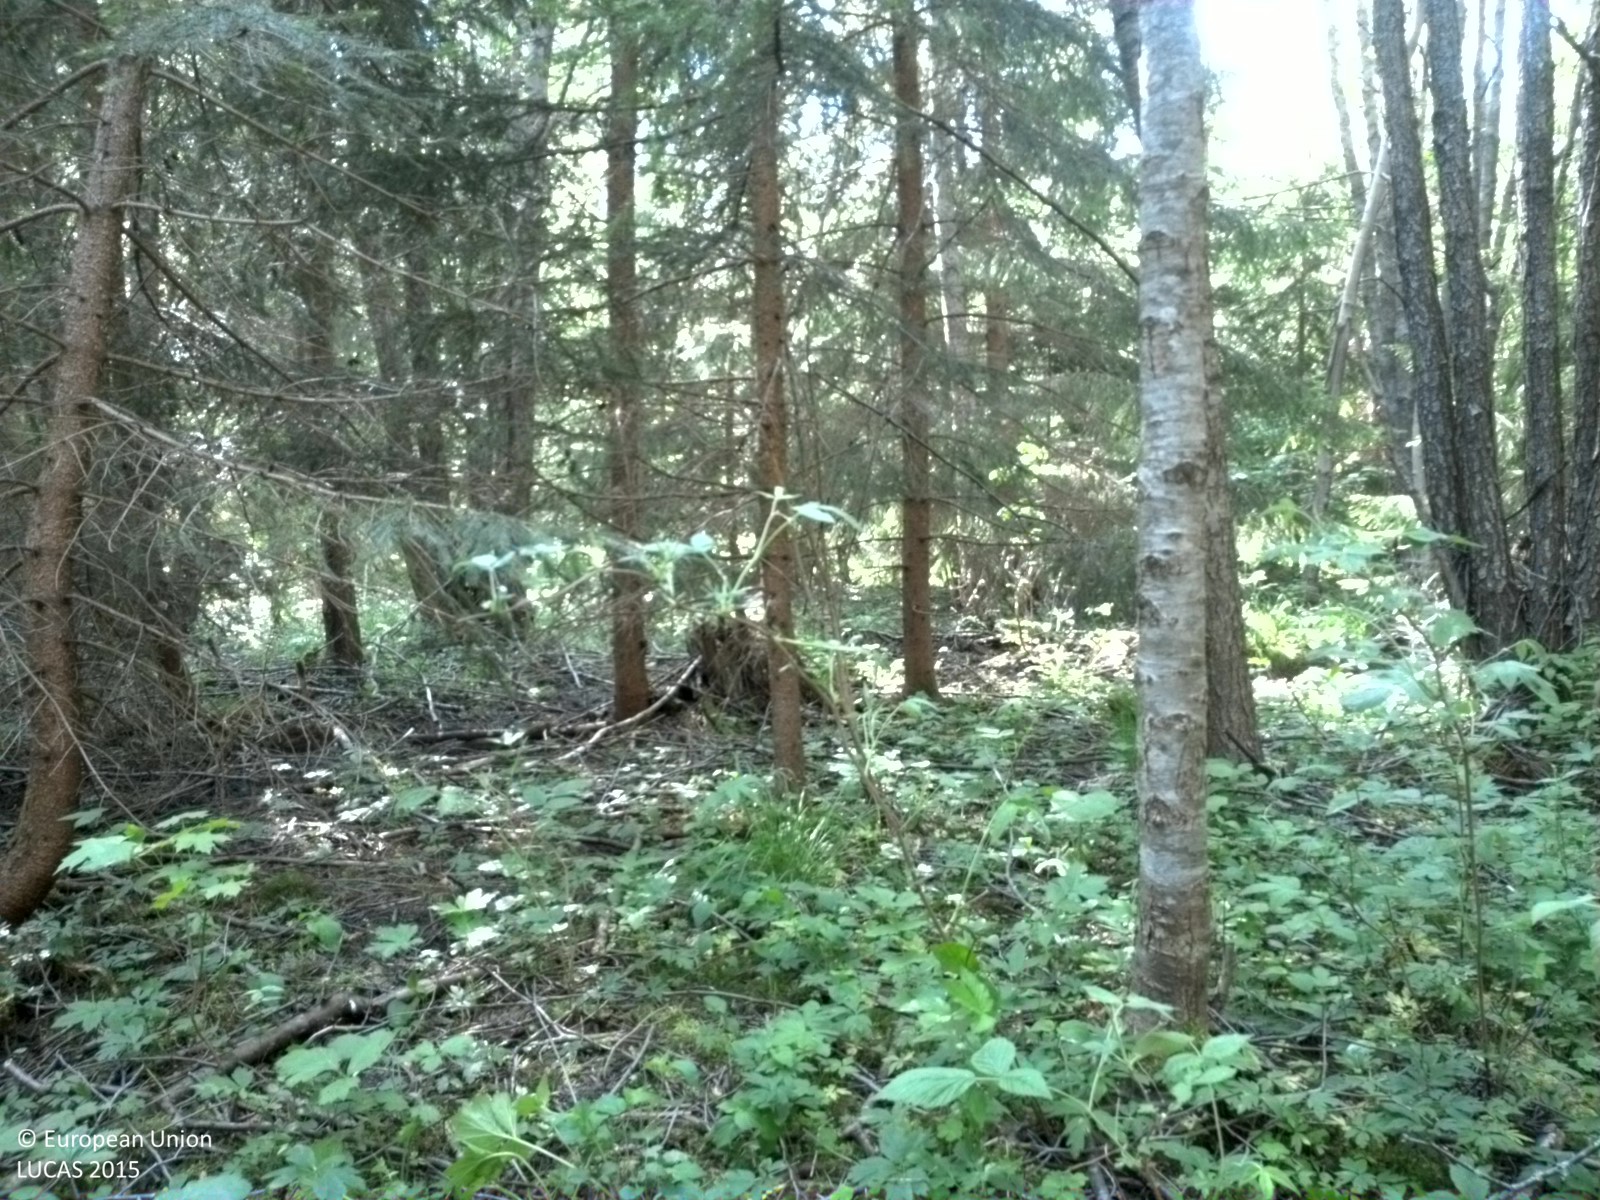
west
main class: Woodland
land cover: Spruce dominated mixed woodland
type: boreal forest
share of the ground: > 75 %
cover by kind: coniferous forest trees 55 %, broadleaved forest trees 20 %, herbaceous plants 10 %, consolidated bare surface 10 %, shrubs 5 %
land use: Forestry
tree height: > 5 m
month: June
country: SE
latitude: 60.2056
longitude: 17.6970
